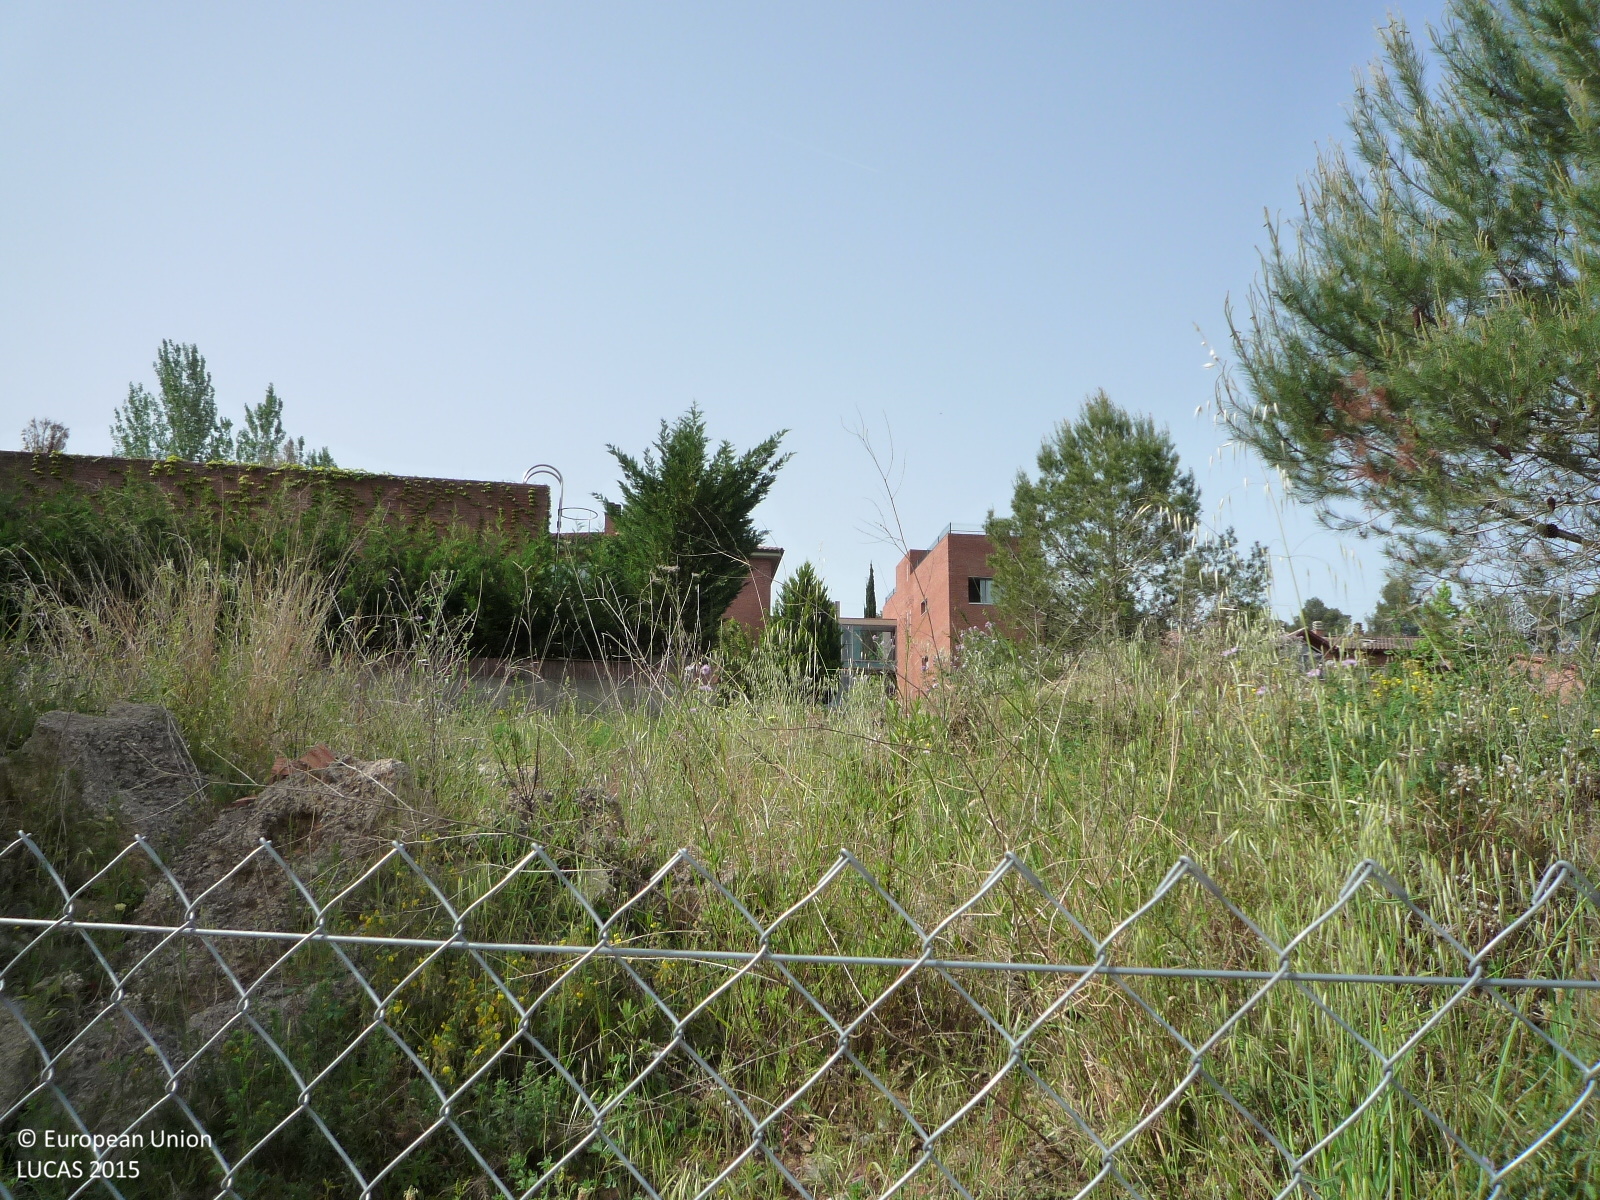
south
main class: Grassland
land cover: Grassland with sparse tree/shrub cover
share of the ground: > 75 %
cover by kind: herbaceous plants 95 %, coniferous forest trees 5 %
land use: Abandoned areas
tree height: < 5 m
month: May
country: ES
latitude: 41.4545
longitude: 2.0807
